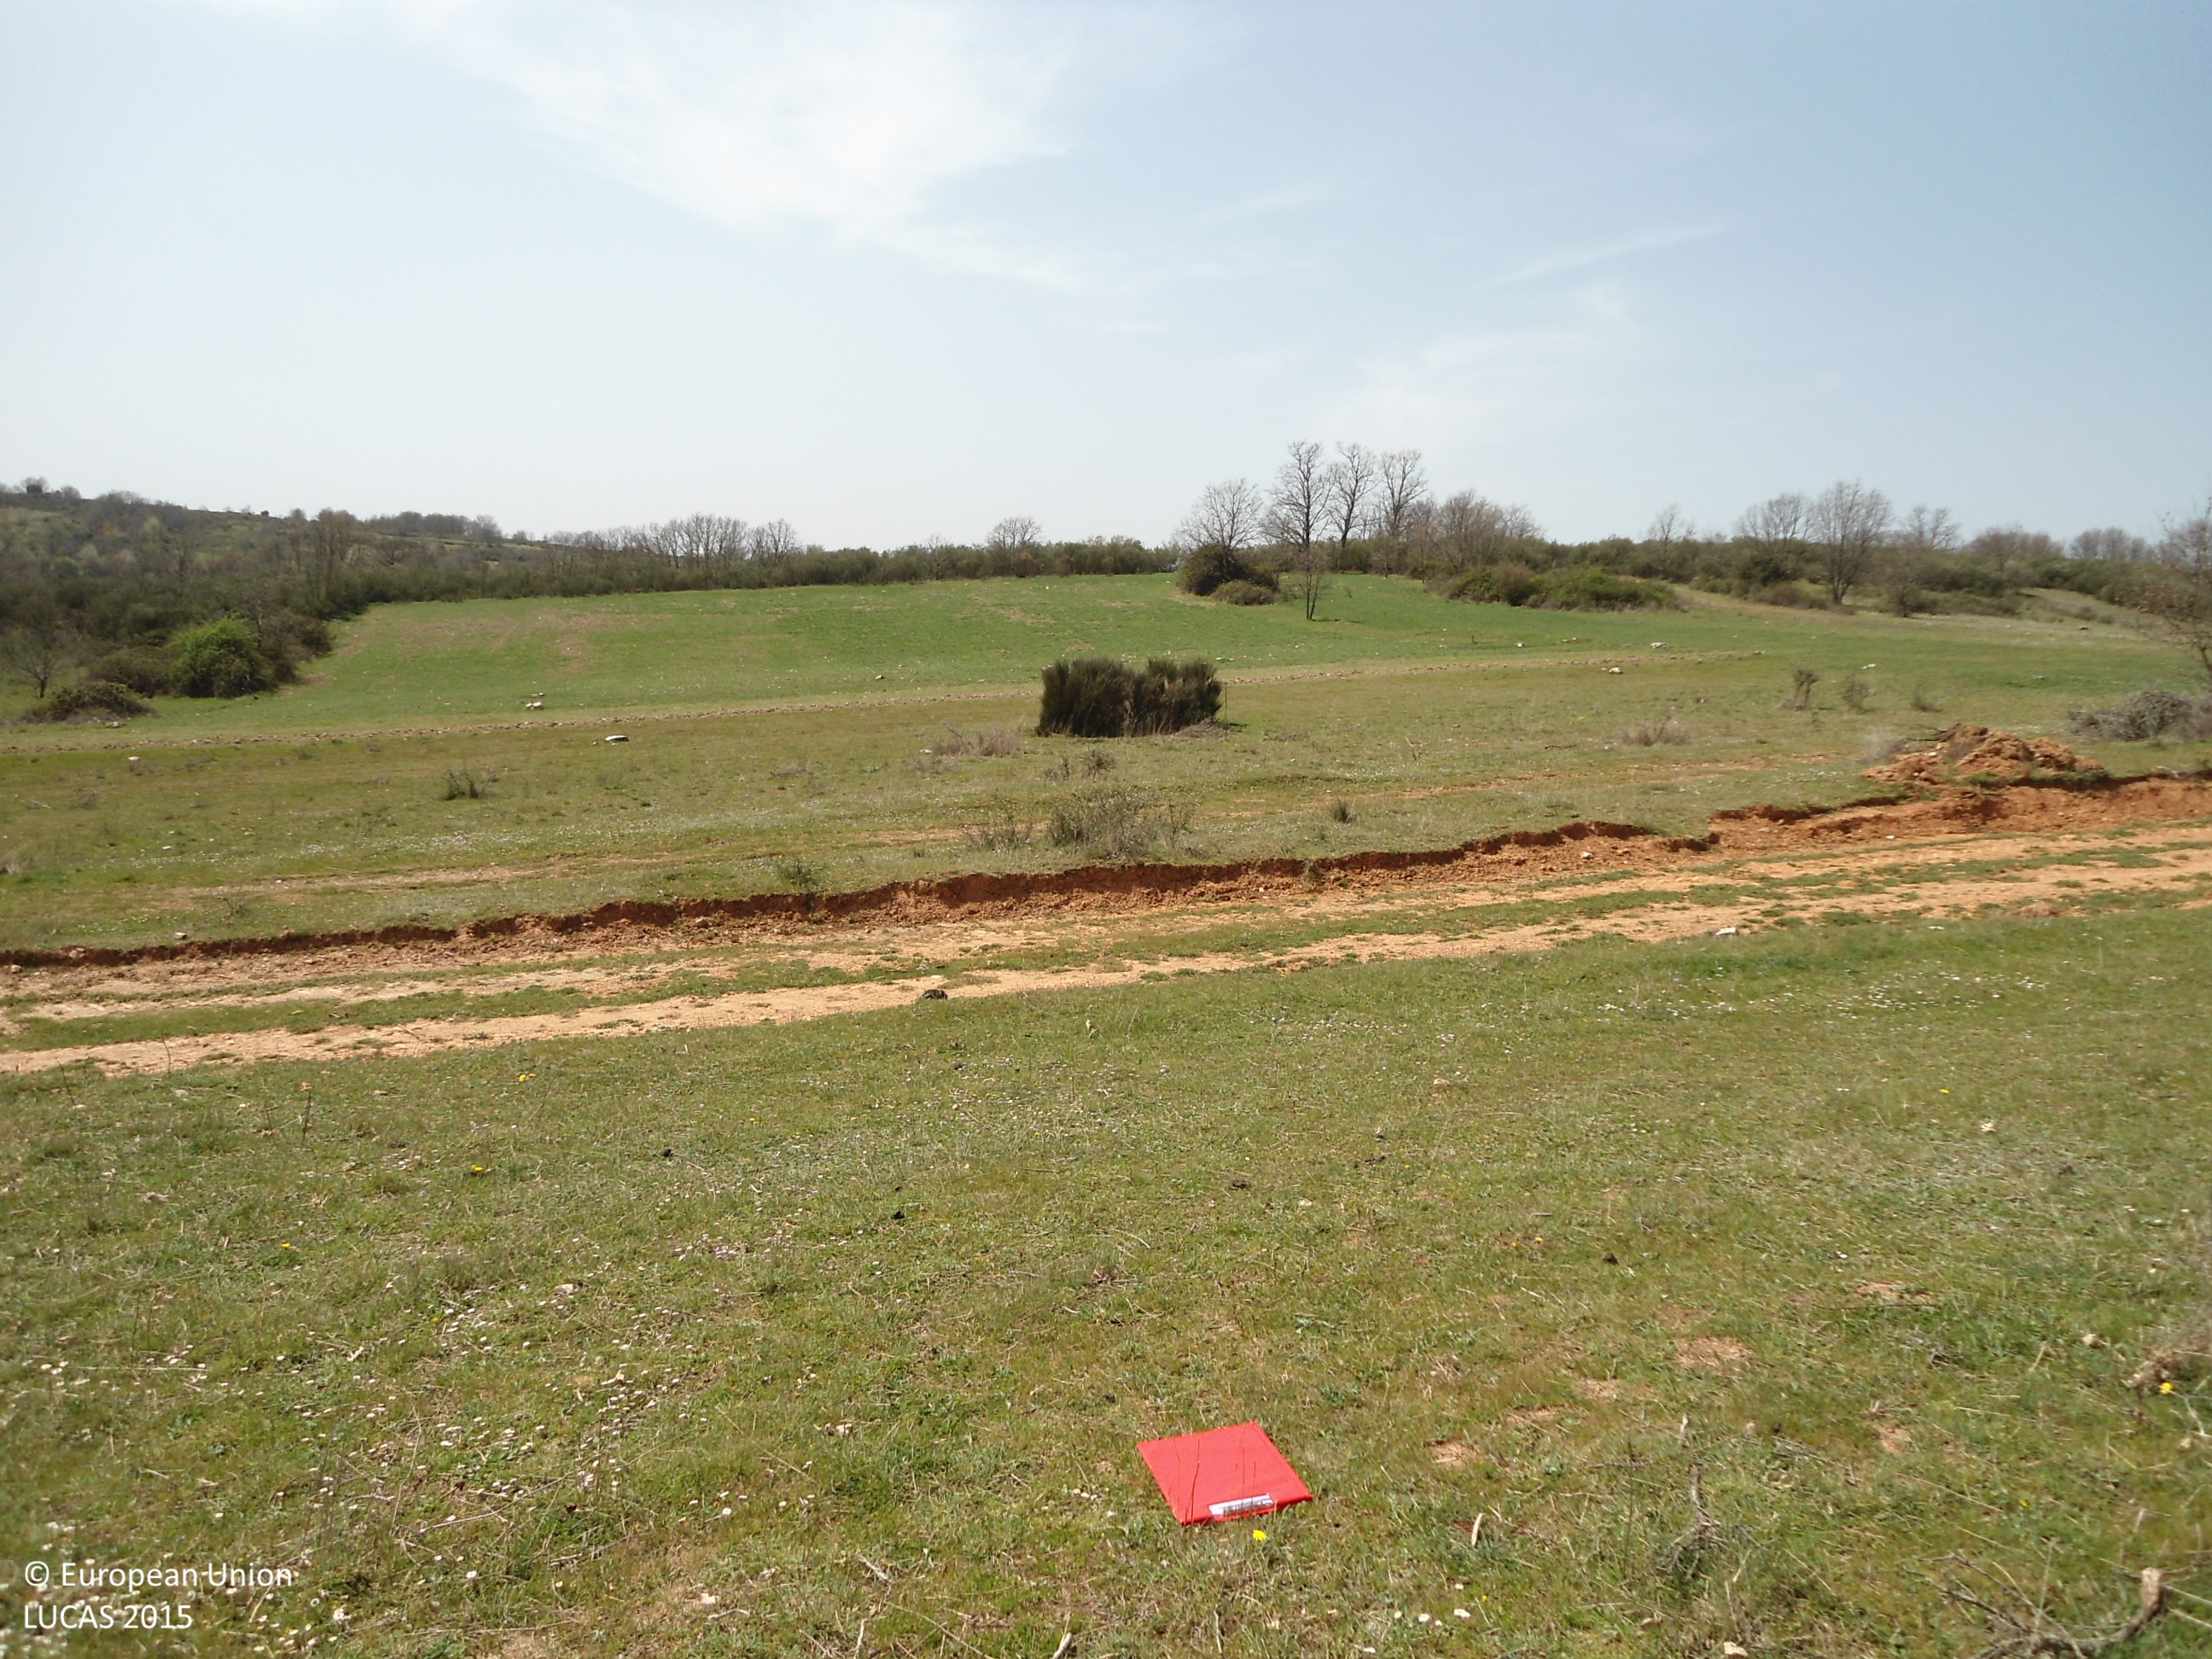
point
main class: Grassland
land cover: Grassland without tree/shrub cover
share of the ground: > 75 %
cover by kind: herbaceous plants 95 %, shrubs 5 %
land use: Agriculture (excluding fallow land and kitchen gardens)
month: April
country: ES
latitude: 41.7443
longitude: -6.4221
